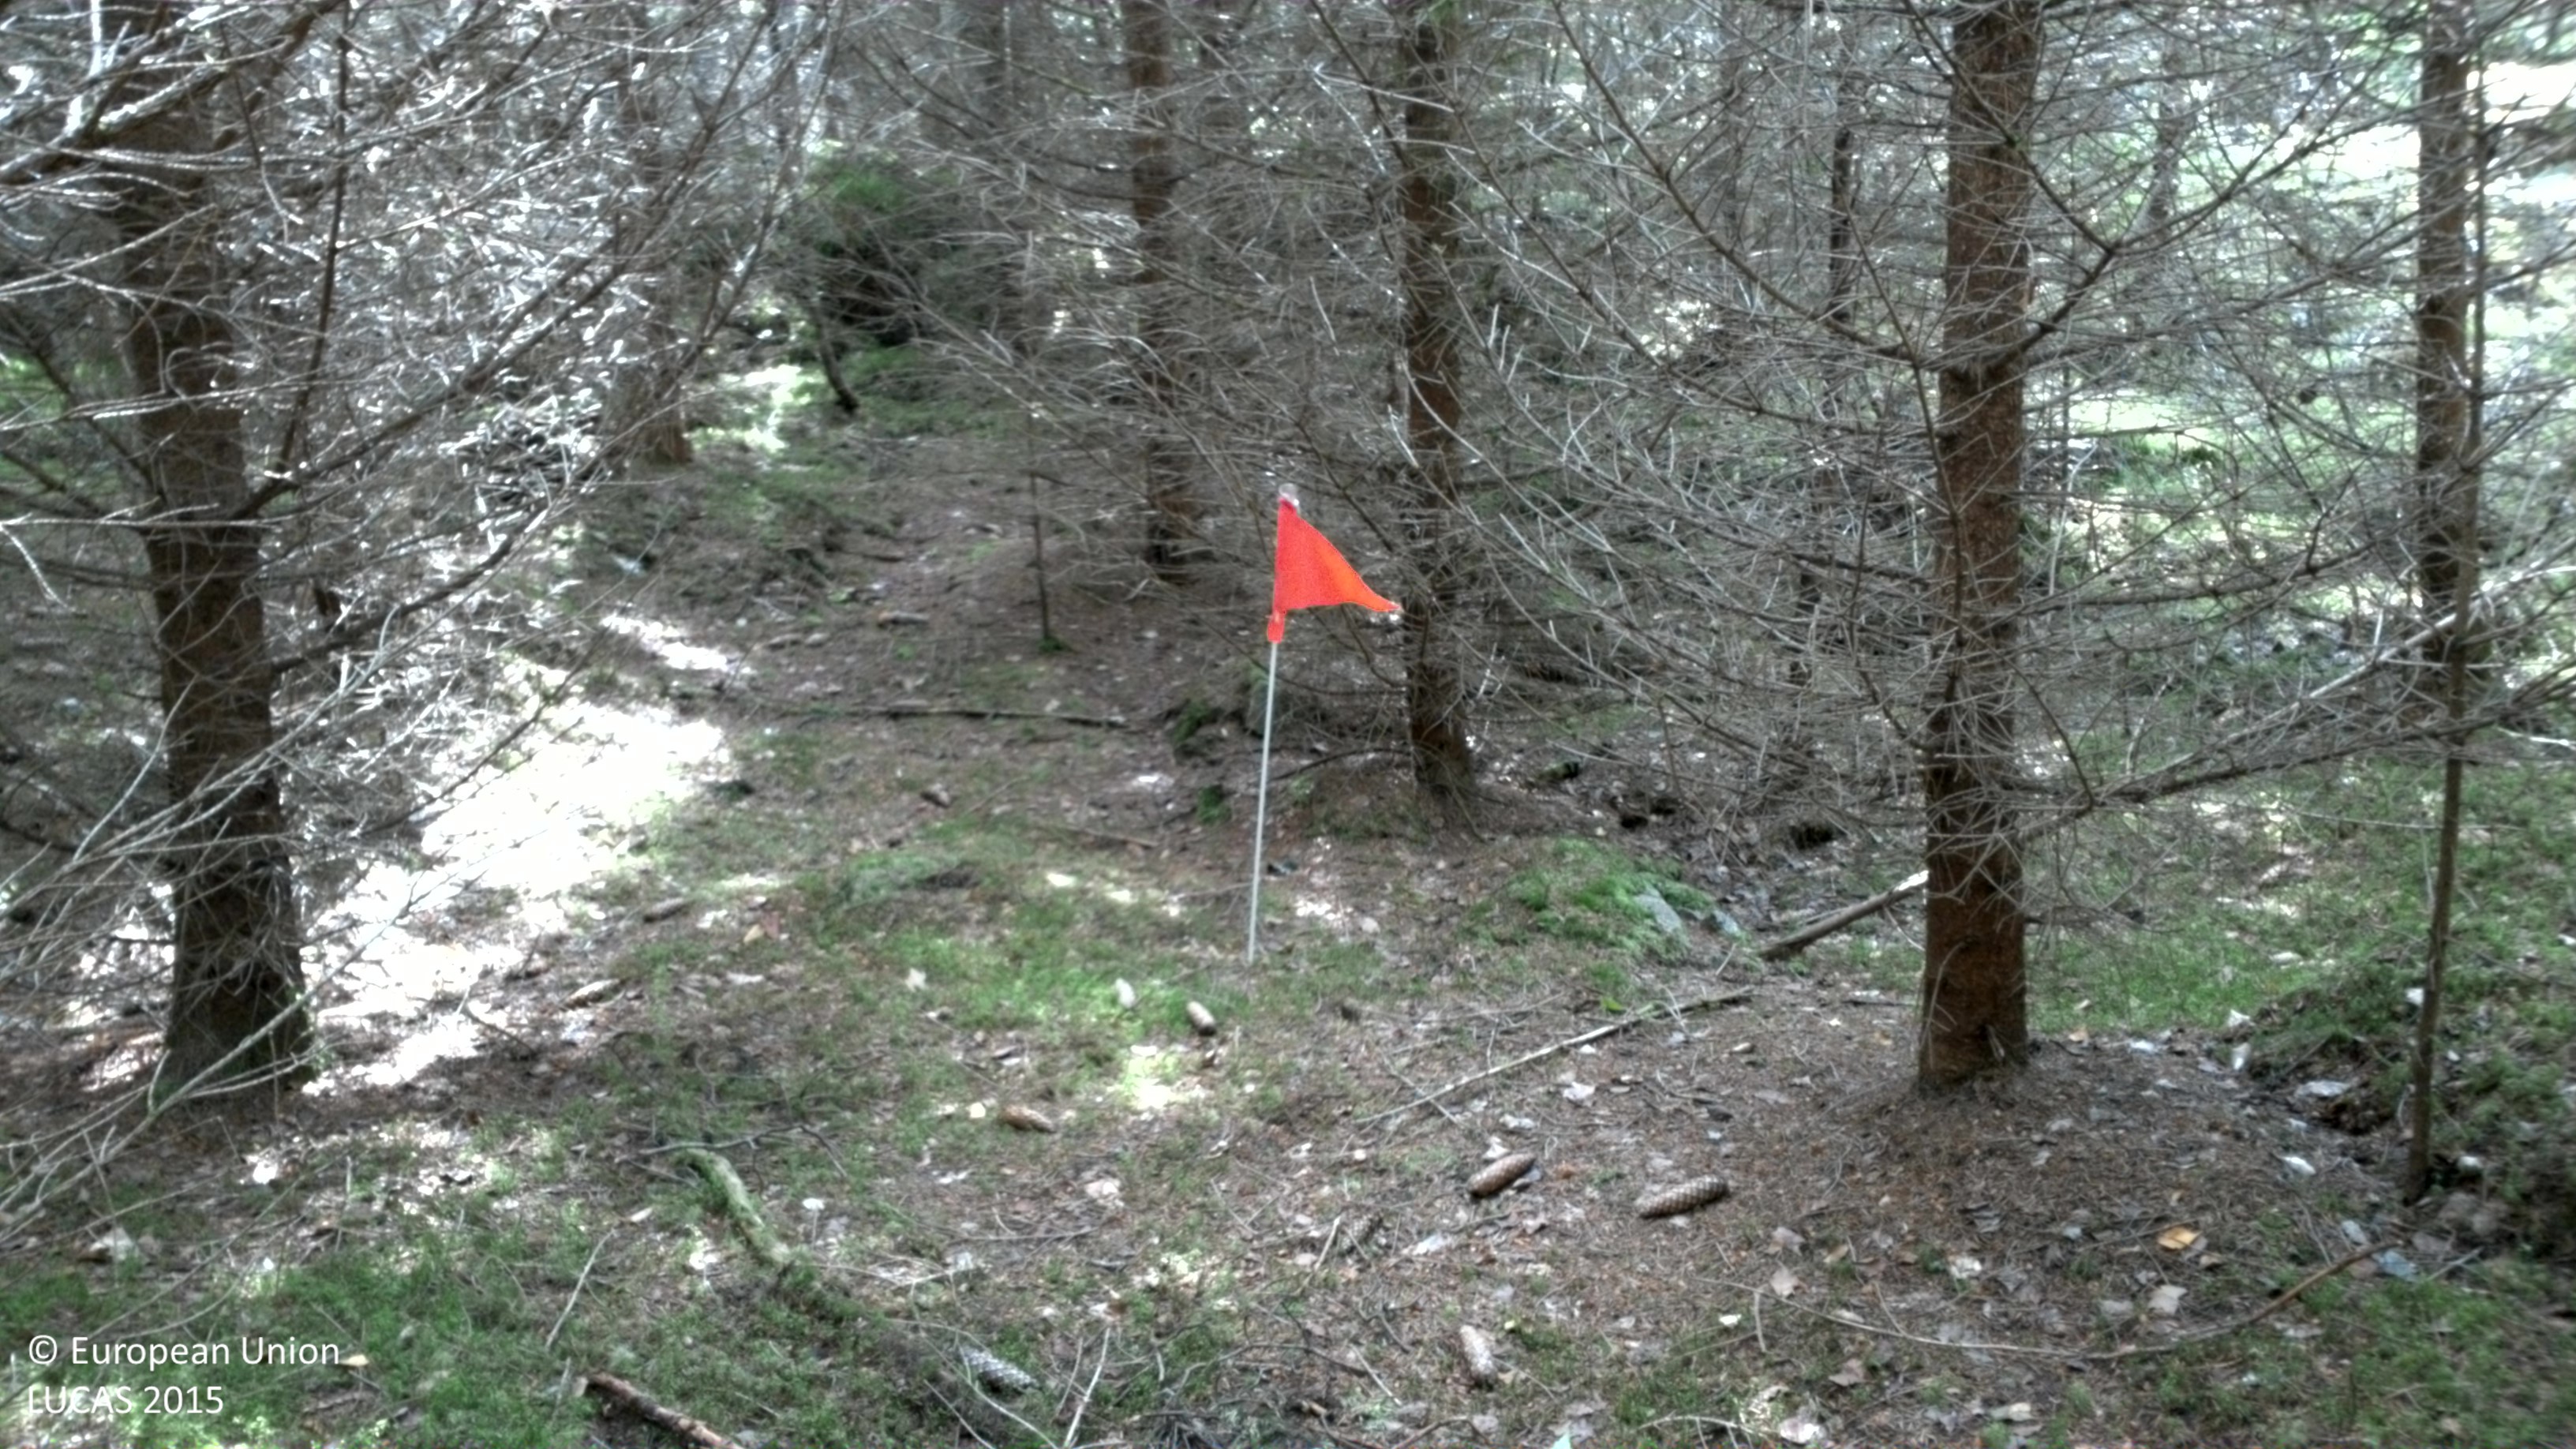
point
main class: Woodland
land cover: Spruce dominated coniferous woodland
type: boreal forest
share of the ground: > 75 %
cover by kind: coniferous forest trees 90 %, lichens and mosses 10 %
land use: Forestry
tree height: < 5 m
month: August
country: SE
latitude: 56.3953
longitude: 14.5501
